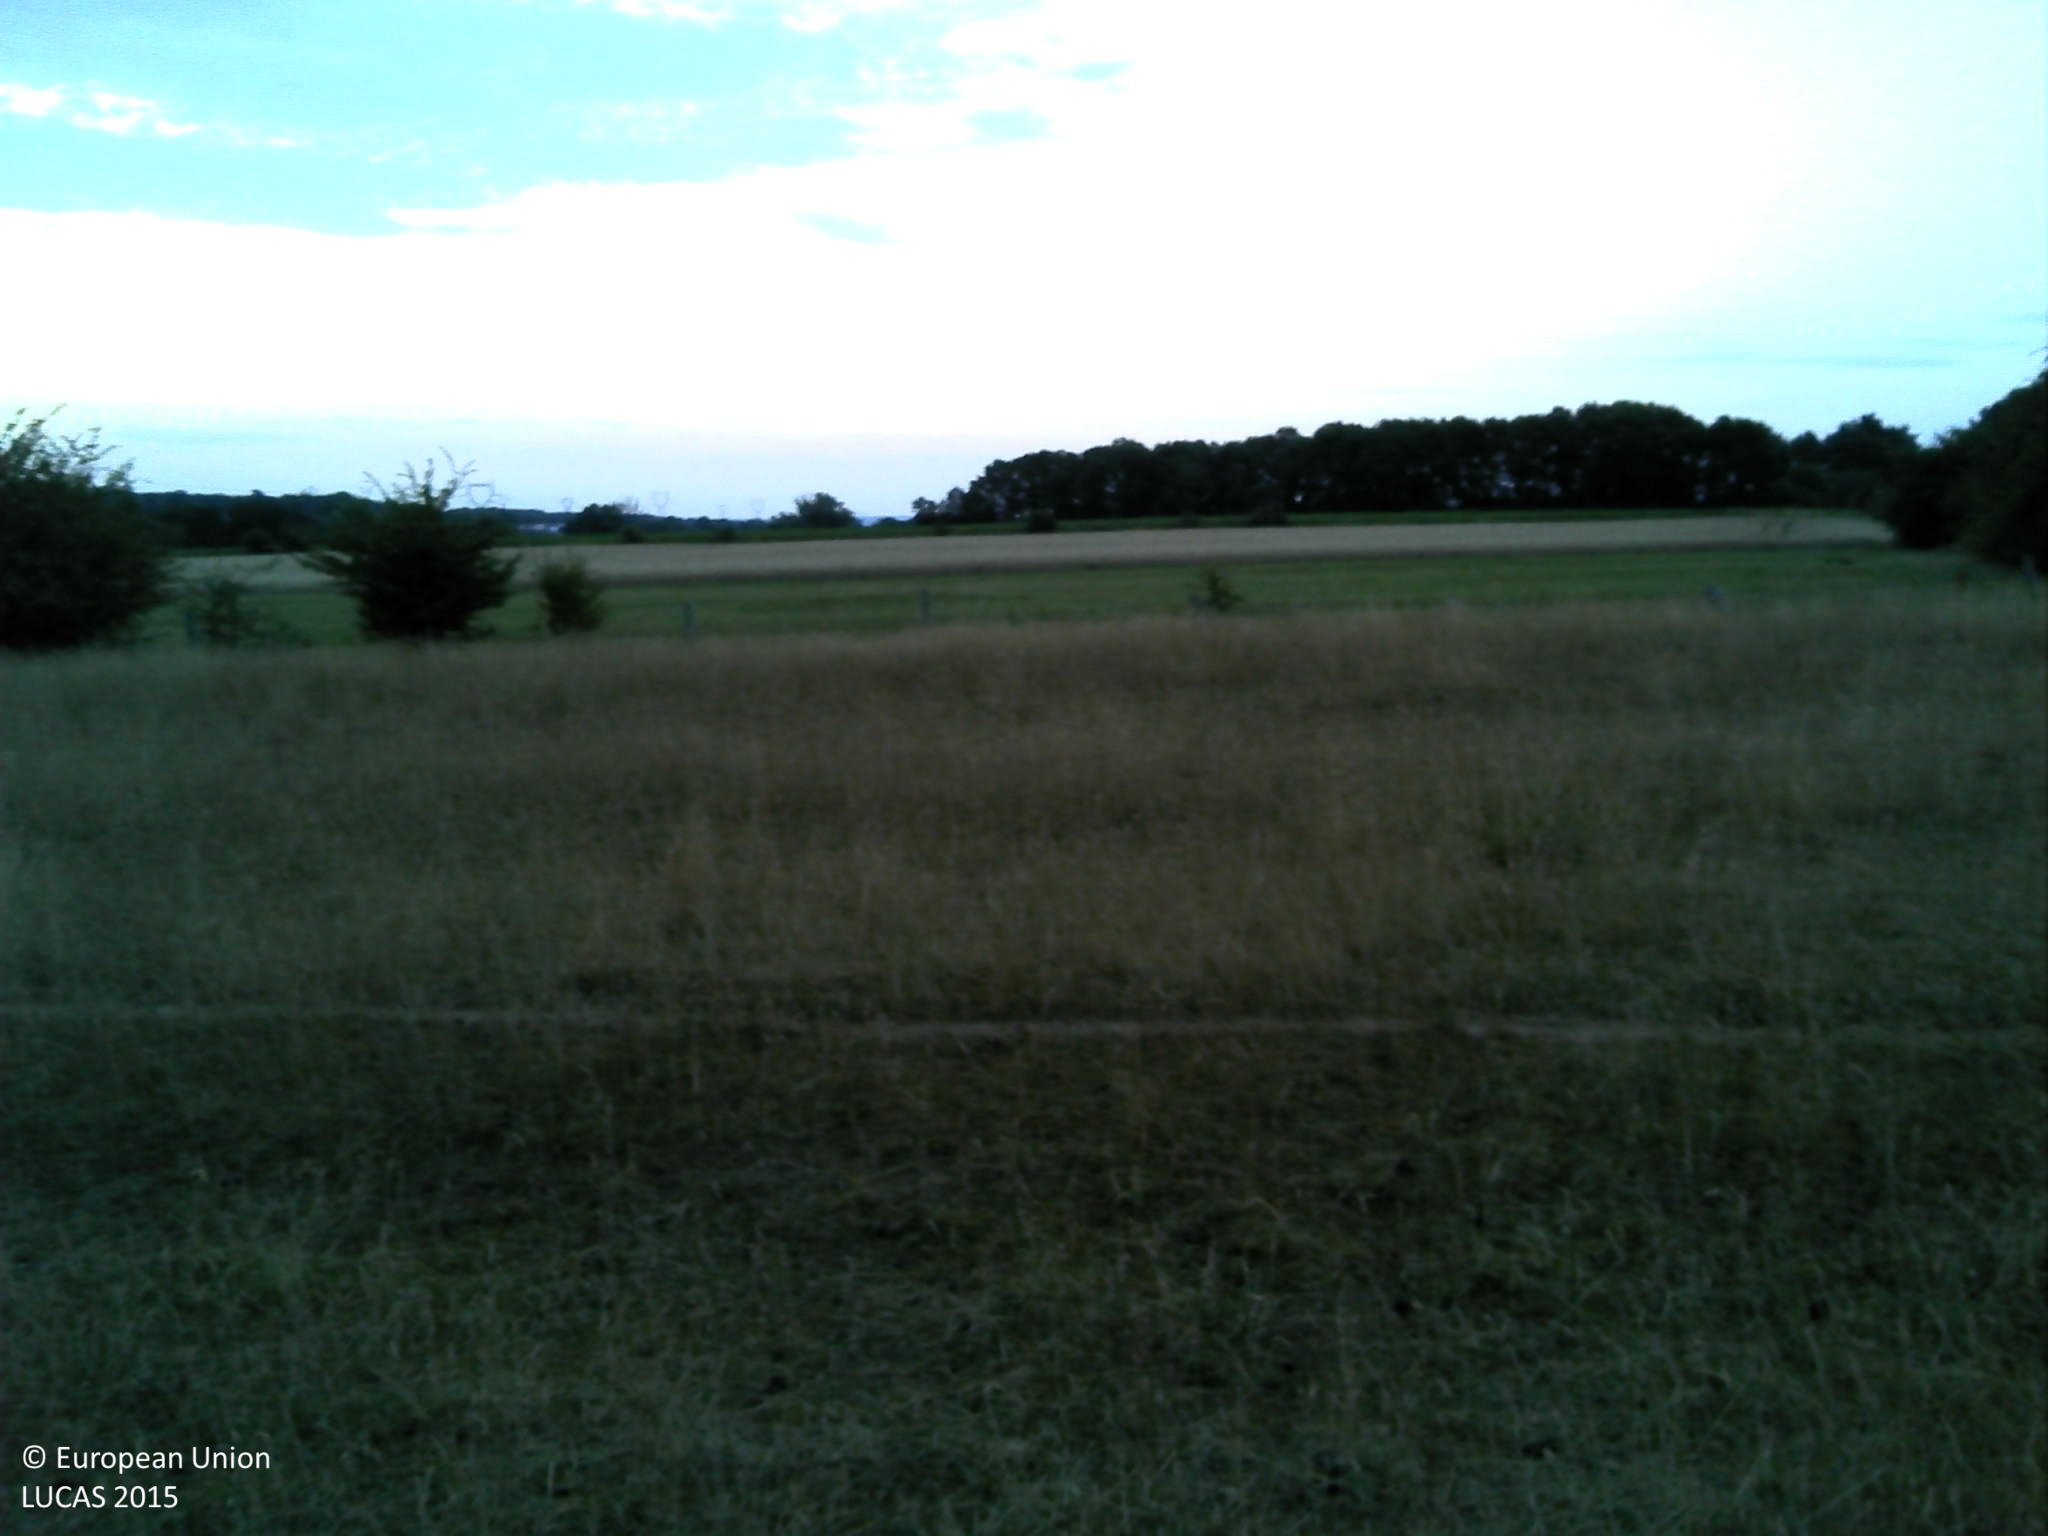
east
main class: Grassland
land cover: Grassland without tree/shrub cover
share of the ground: > 75 %
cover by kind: herbaceous plants 100 %
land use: Agriculture (excluding fallow land and kitchen gardens)
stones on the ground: < 10 %
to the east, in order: Grassland without tree/shrub cover; Electric lines; Grassland without tree/shrub cover; Fences; Grassland without tree/shrub cover; Common wheat; Durum wheat; Grass margins; Fences; Grass margins; Maize
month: July
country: FR
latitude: 48.2585
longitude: 6.5120
